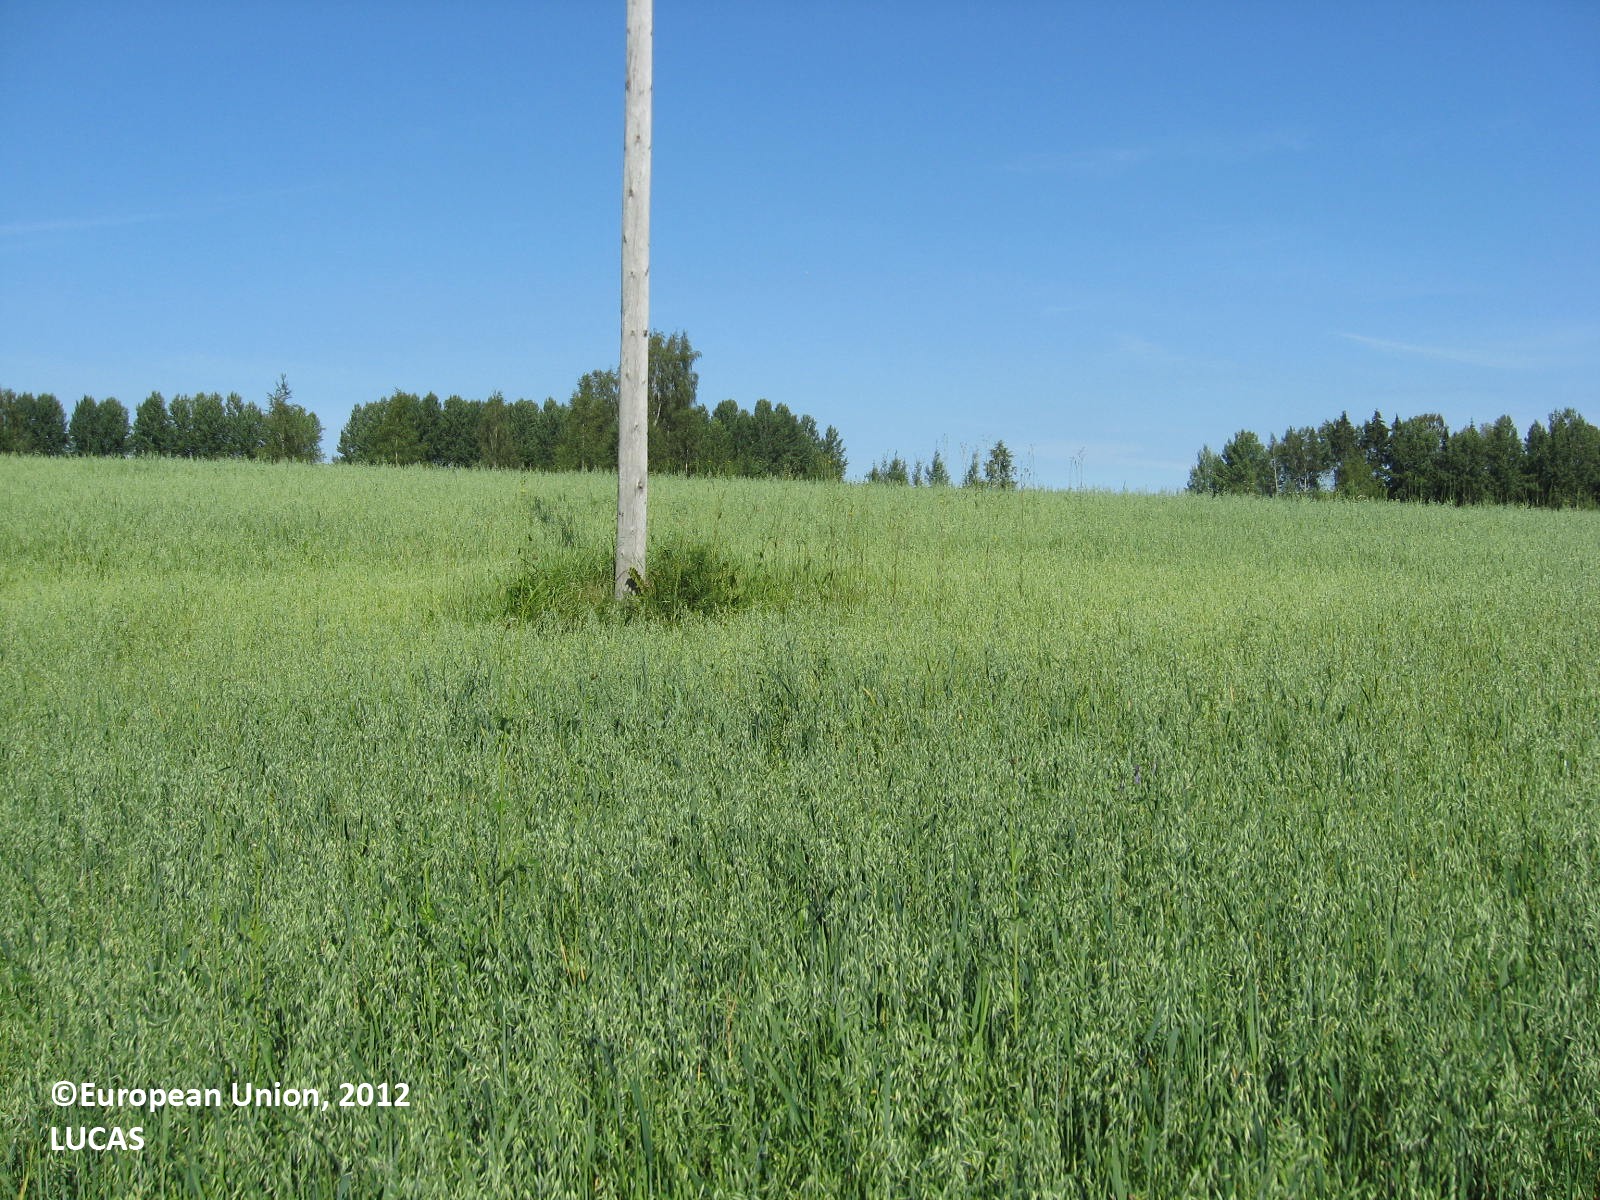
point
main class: Cropland
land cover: Oats
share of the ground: > 75 %
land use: Agriculture (excluding fallow land and kitchen gardens)
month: July
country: FI
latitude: 61.8747
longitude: 22.8636
